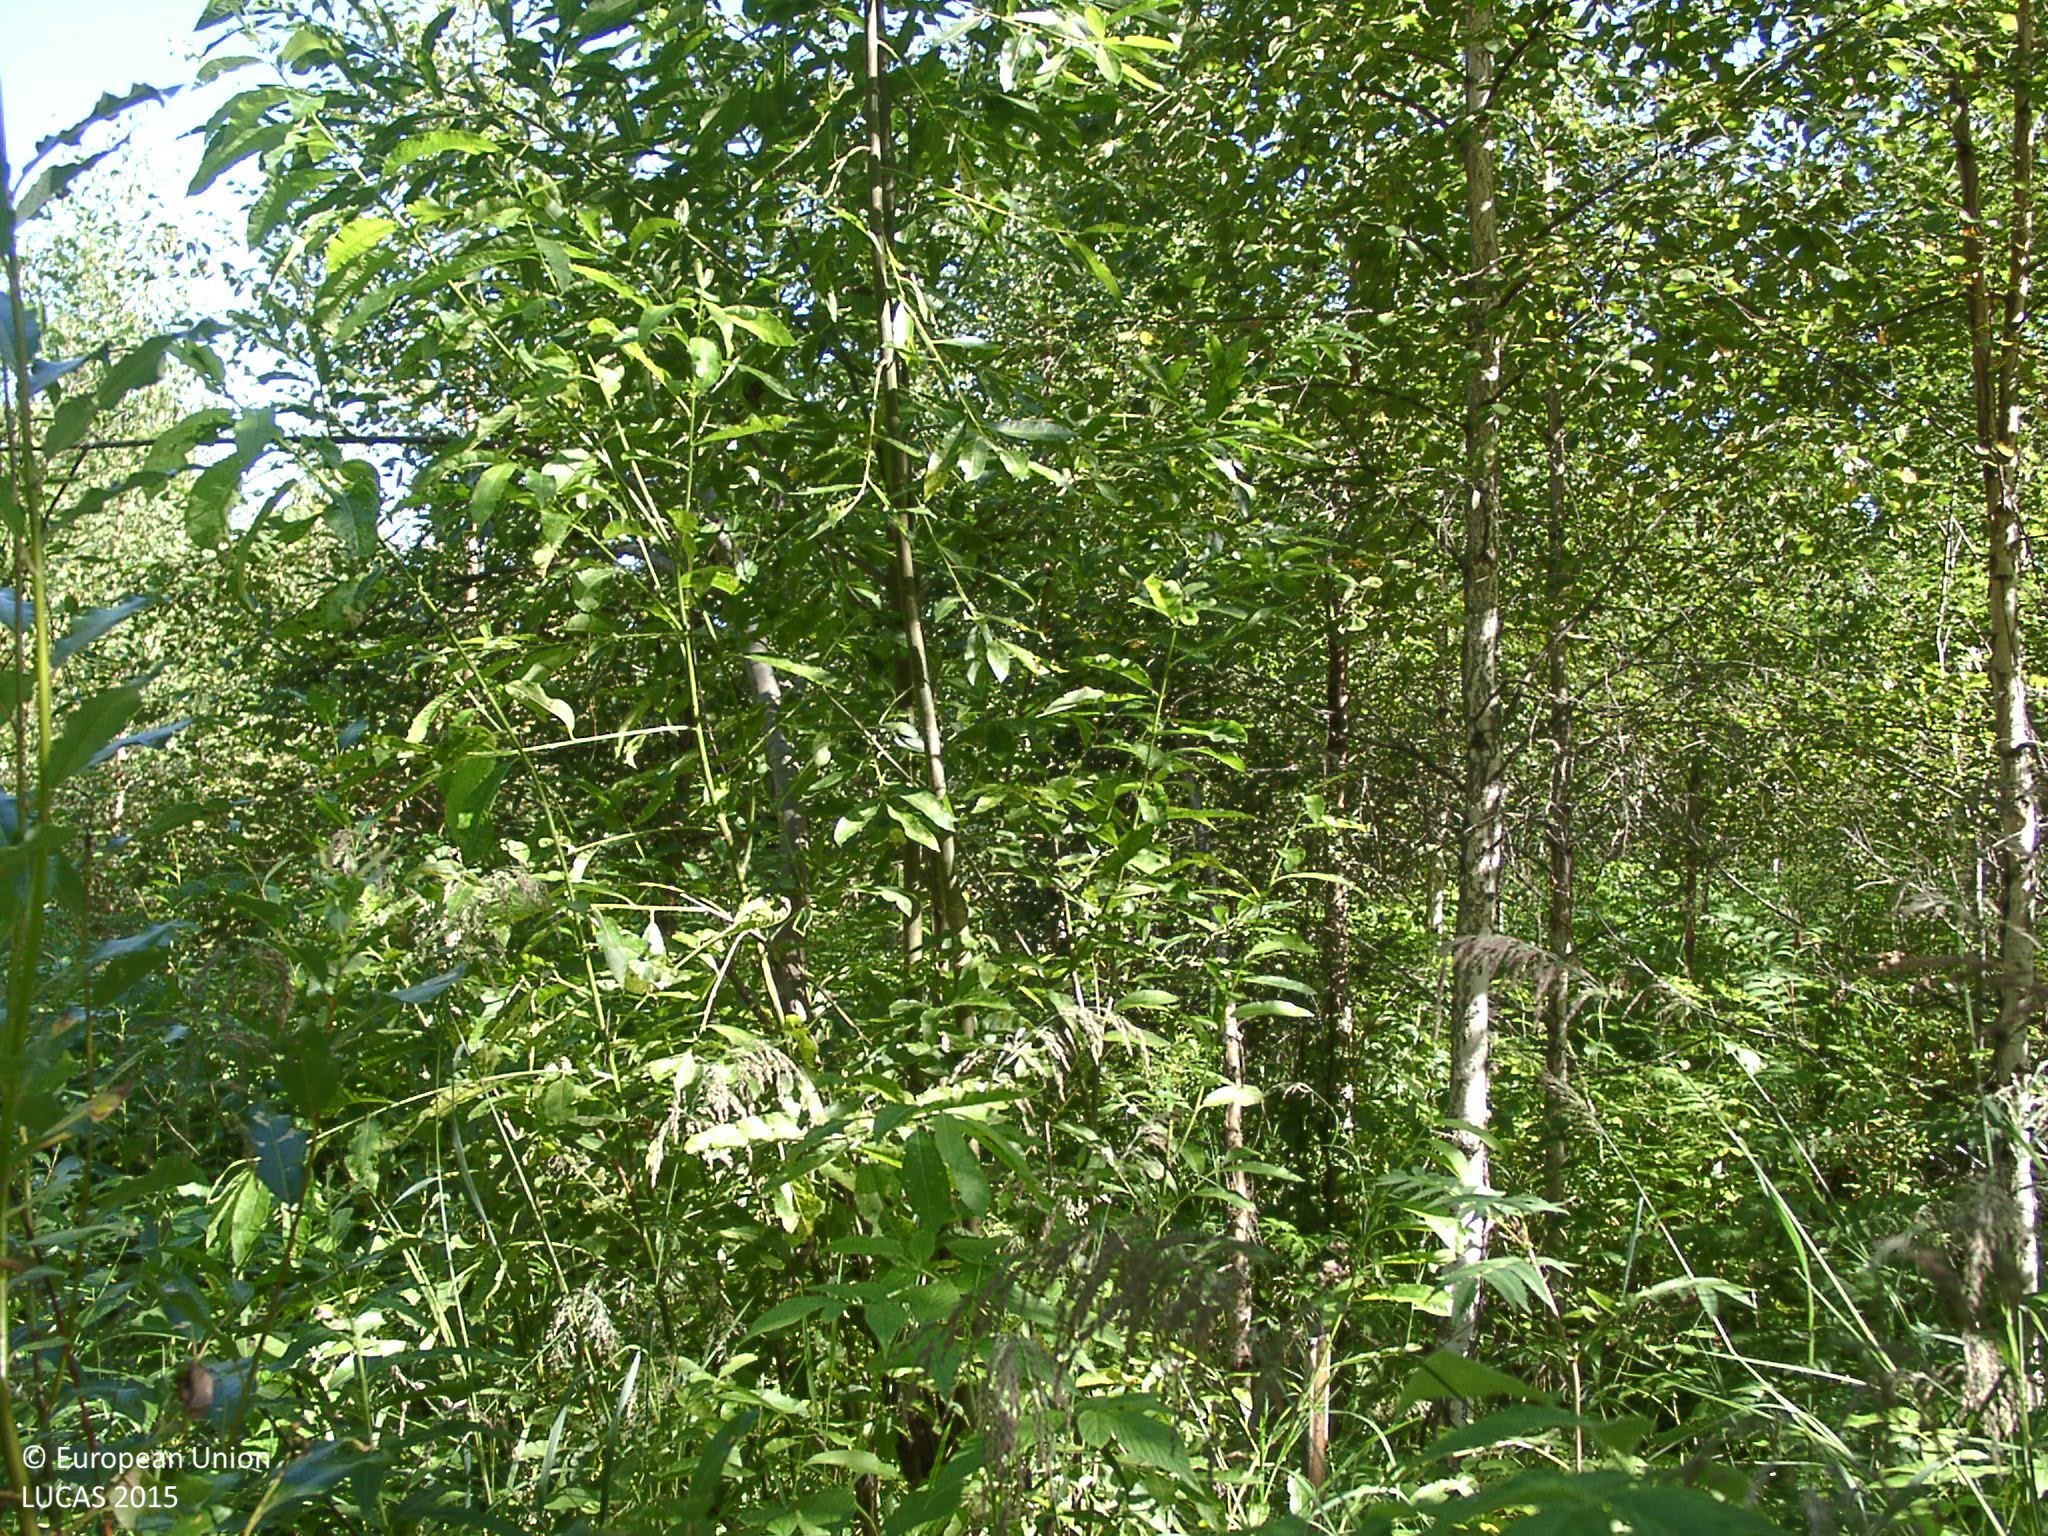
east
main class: Woodland
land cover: Broadleaved woodland
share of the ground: 50 - 75 %
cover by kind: broadleaved forest trees 60 %, shrubs 20 %, herbaceous plants 20 %
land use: Forestry
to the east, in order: Broadleaved woodland; Ditches and canals; Broadleaved woodland; Other mixed woodland; Spruce dominated mixed woodland; Other coniferous woodland; Spruce dominated coniferous woodland; Shruby margins; Ditches and canals; Other coniferous woodland; Ditches and canals; Managed hedges; Paved roads, cycling and walking lanes; Managed hedges; Ditches and canals; Other mixed woodland
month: August
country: FI
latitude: 62.3703
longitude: 25.3601
